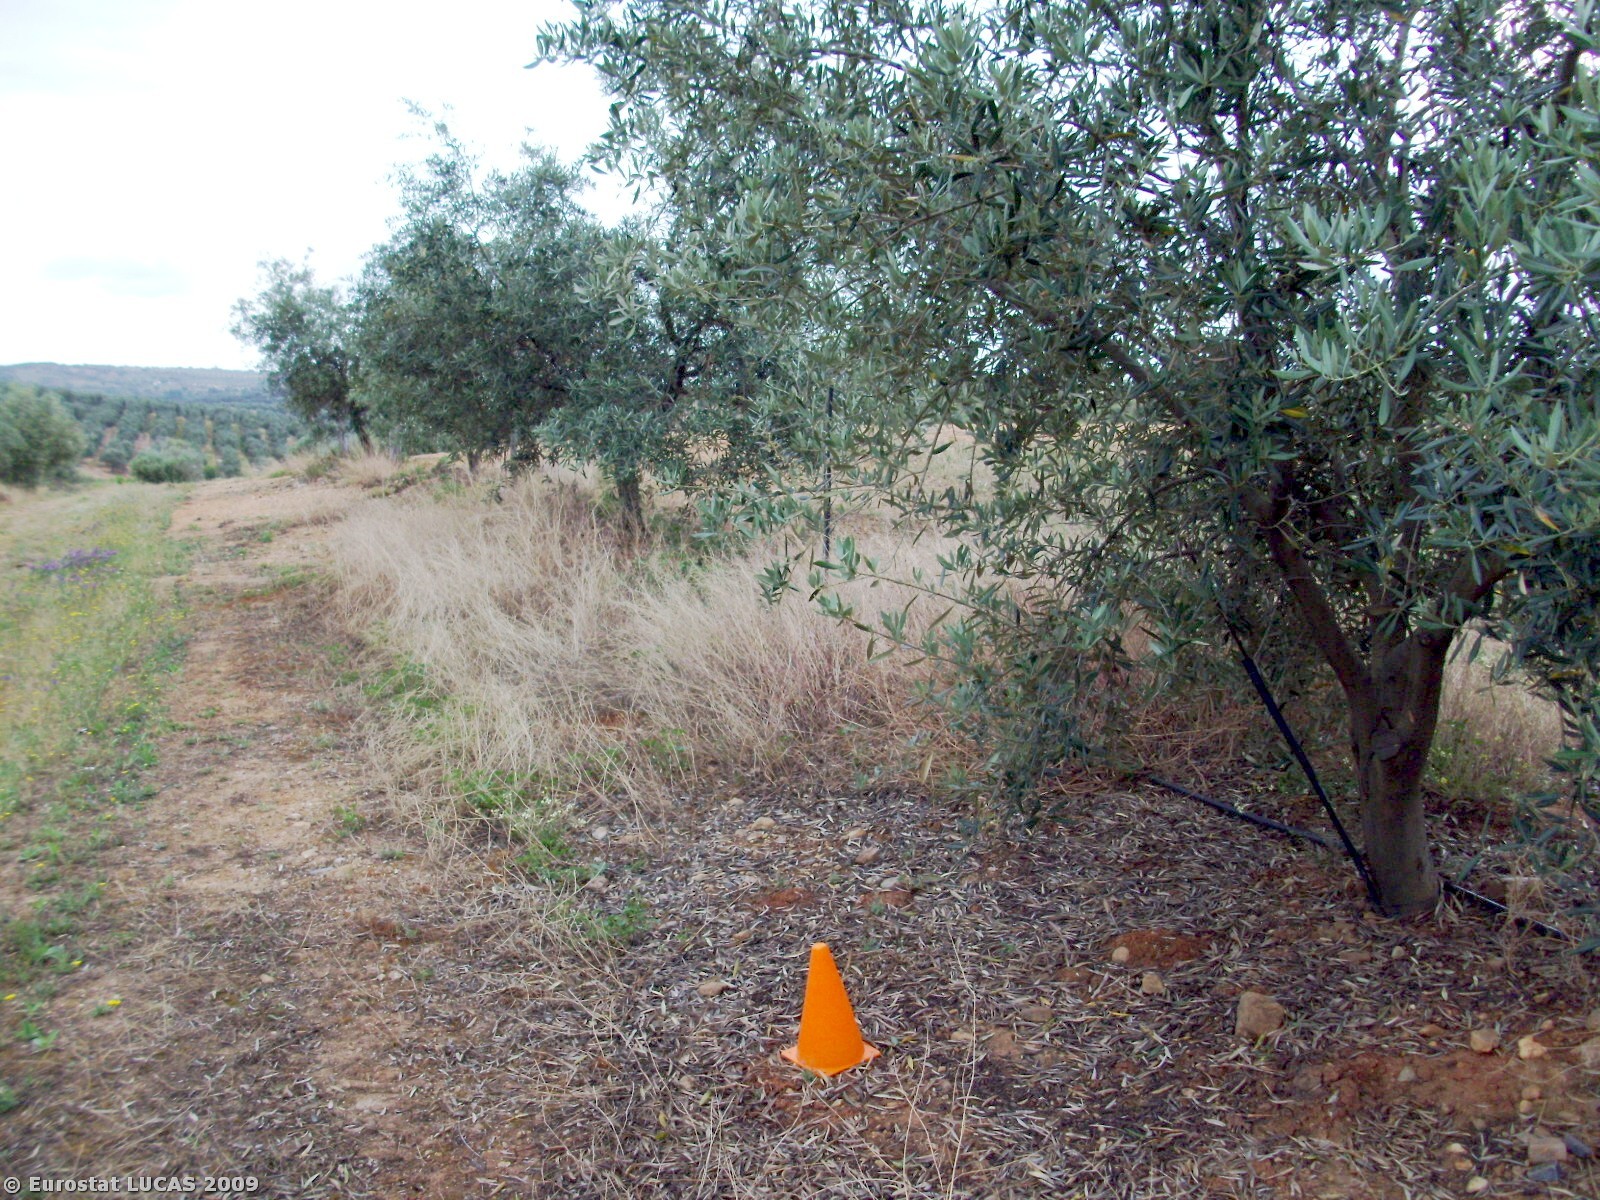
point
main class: Cropland
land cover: Olive groves
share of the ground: 25 - 50 %
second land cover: Spontaneously vegetated surfaces
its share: 50 - 75 %
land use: Agriculture (excluding fallow land and kitchen gardens)
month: May
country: PT
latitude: 39.1934
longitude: -7.8217
